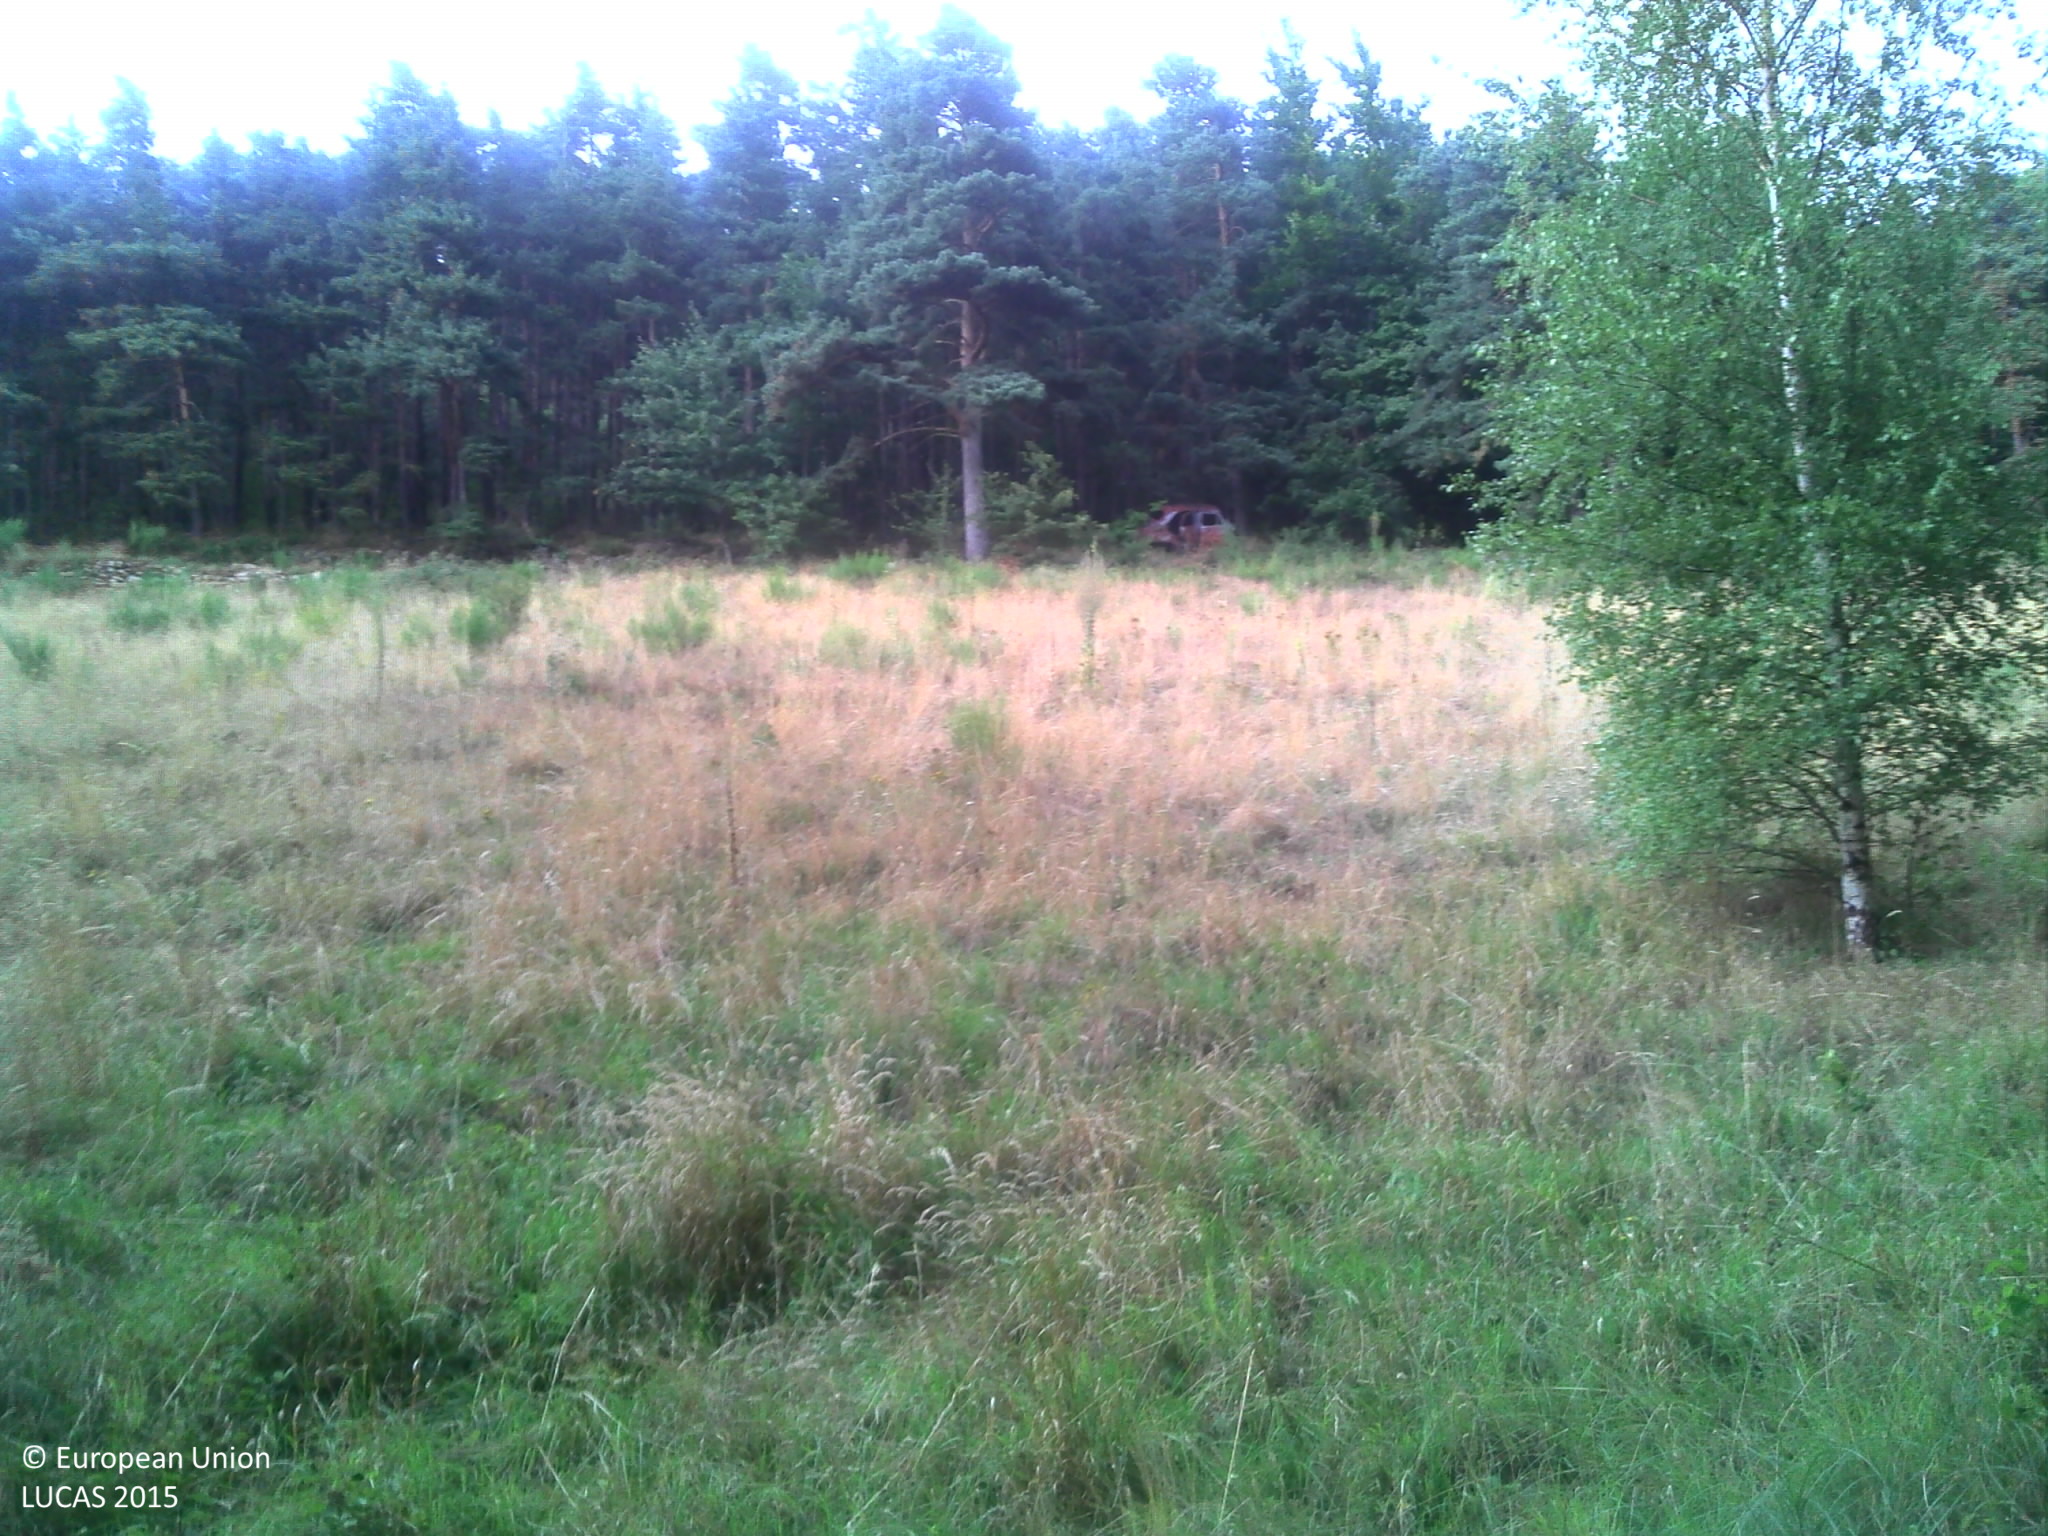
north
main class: Woodland
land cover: Spruce dominated mixed woodland
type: mountainous beech forest
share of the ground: > 75 %
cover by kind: coniferous forest trees 40 %, broadleaved forest trees 35 %, herbaceous plants 15 %, unconsolidated bare surface 10 %
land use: Forestry
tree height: > 5 m
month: August
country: FR
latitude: 45.2034
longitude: 4.5941
